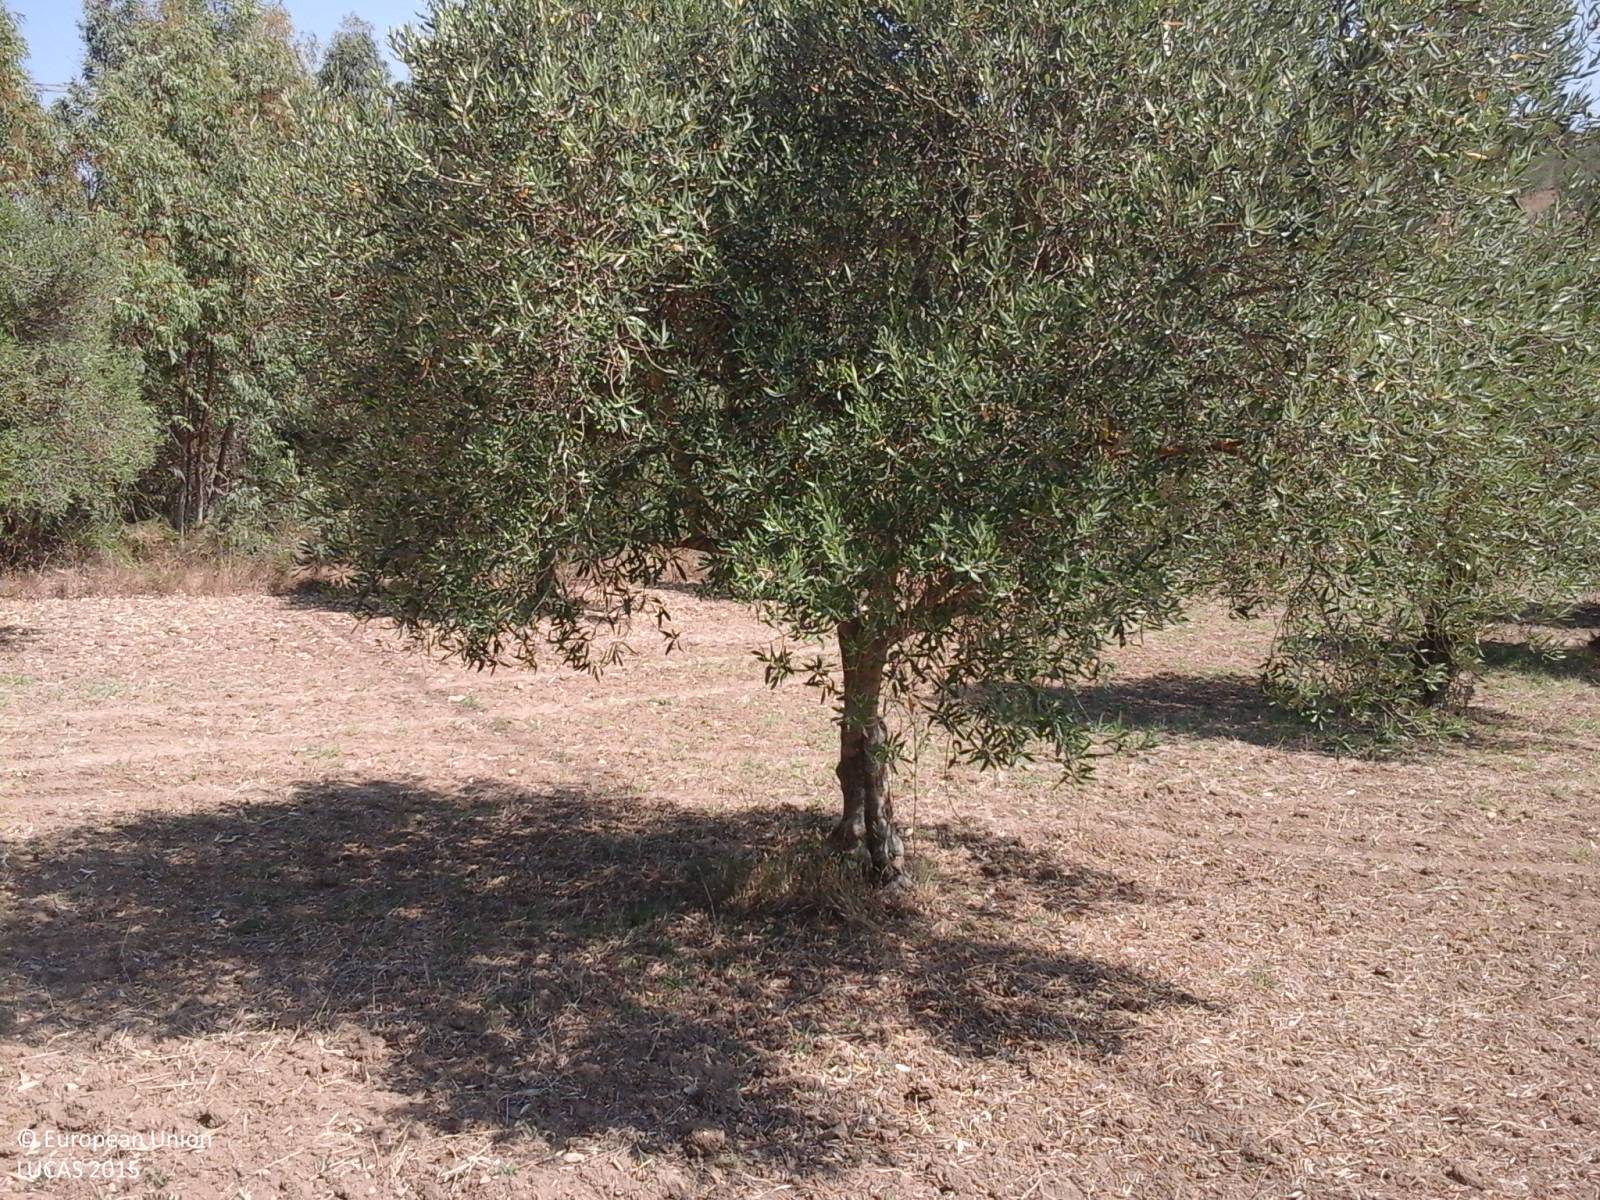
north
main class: Cropland
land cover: Olive groves
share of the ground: > 75 %
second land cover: Other bare soil
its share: > 75 %
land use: Agriculture (excluding fallow land and kitchen gardens)
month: July
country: IT
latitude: 39.6273
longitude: 8.8996
